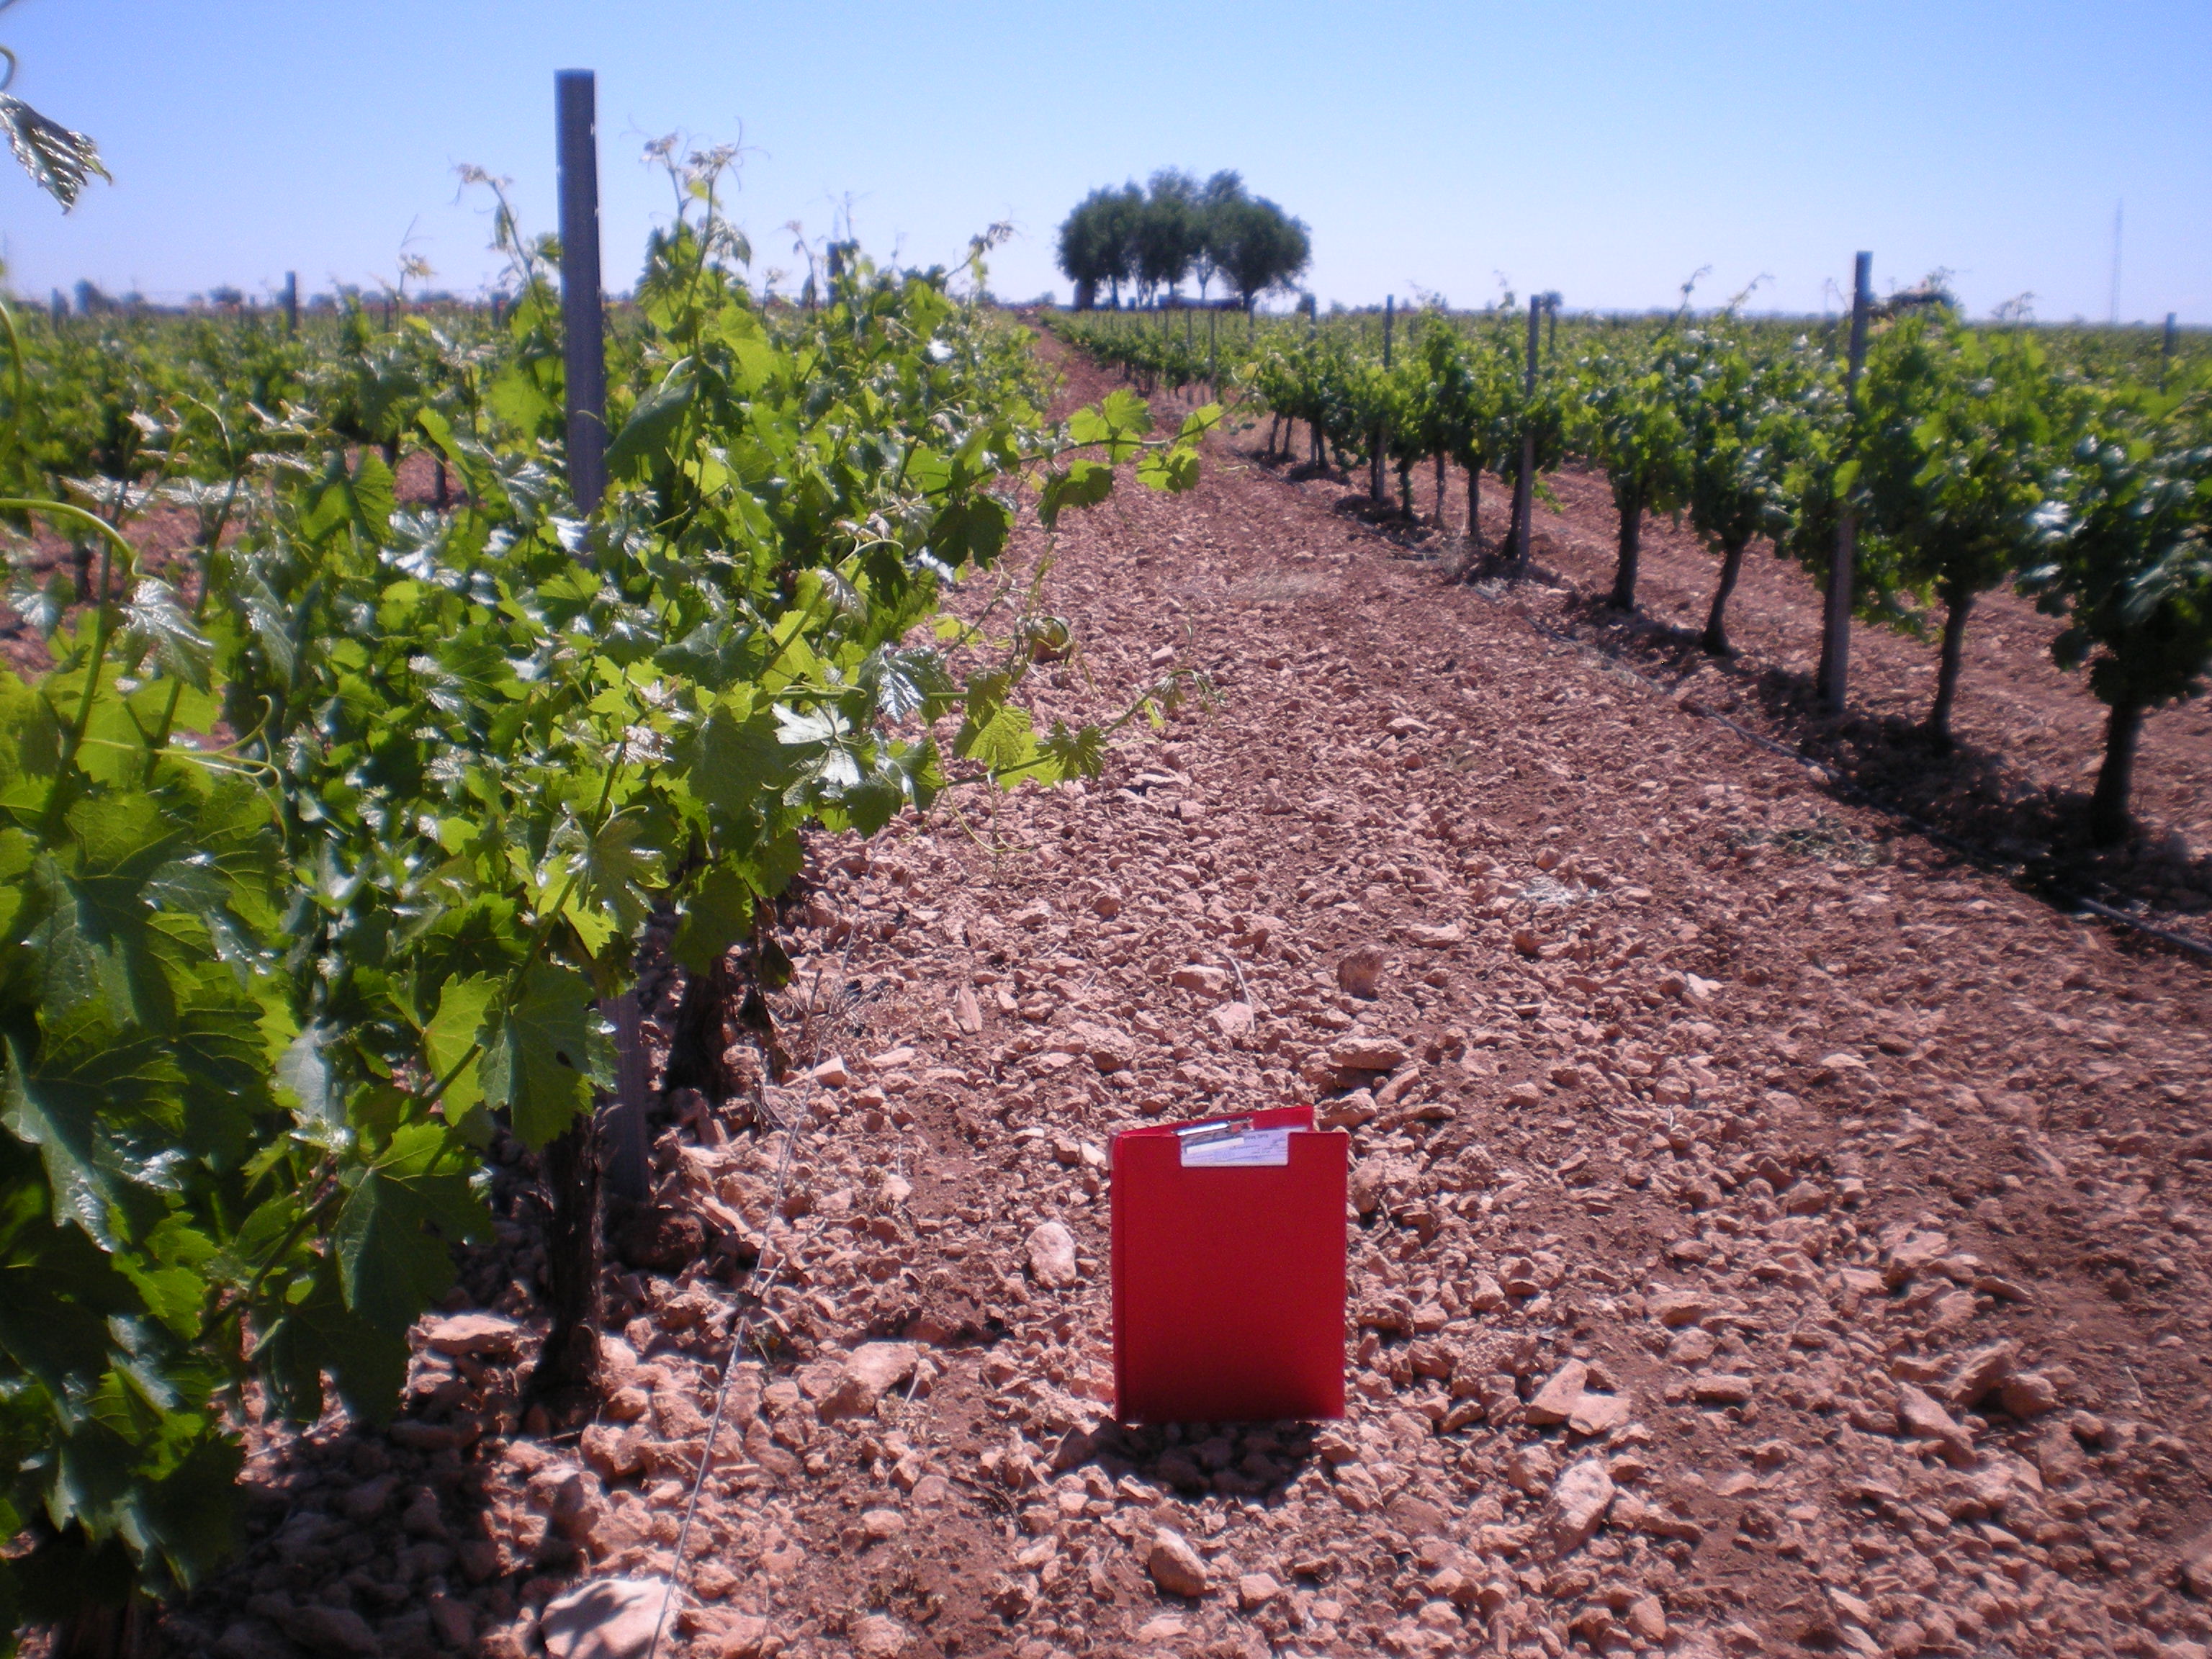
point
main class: Cropland
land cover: Vineyards
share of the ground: 10 - 25 %
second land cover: Other bare soil
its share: > 75 %
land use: Agriculture (excluding fallow land and kitchen gardens)
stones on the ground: 25 - 50 %
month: May
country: ES
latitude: 39.1428
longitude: -3.2627
